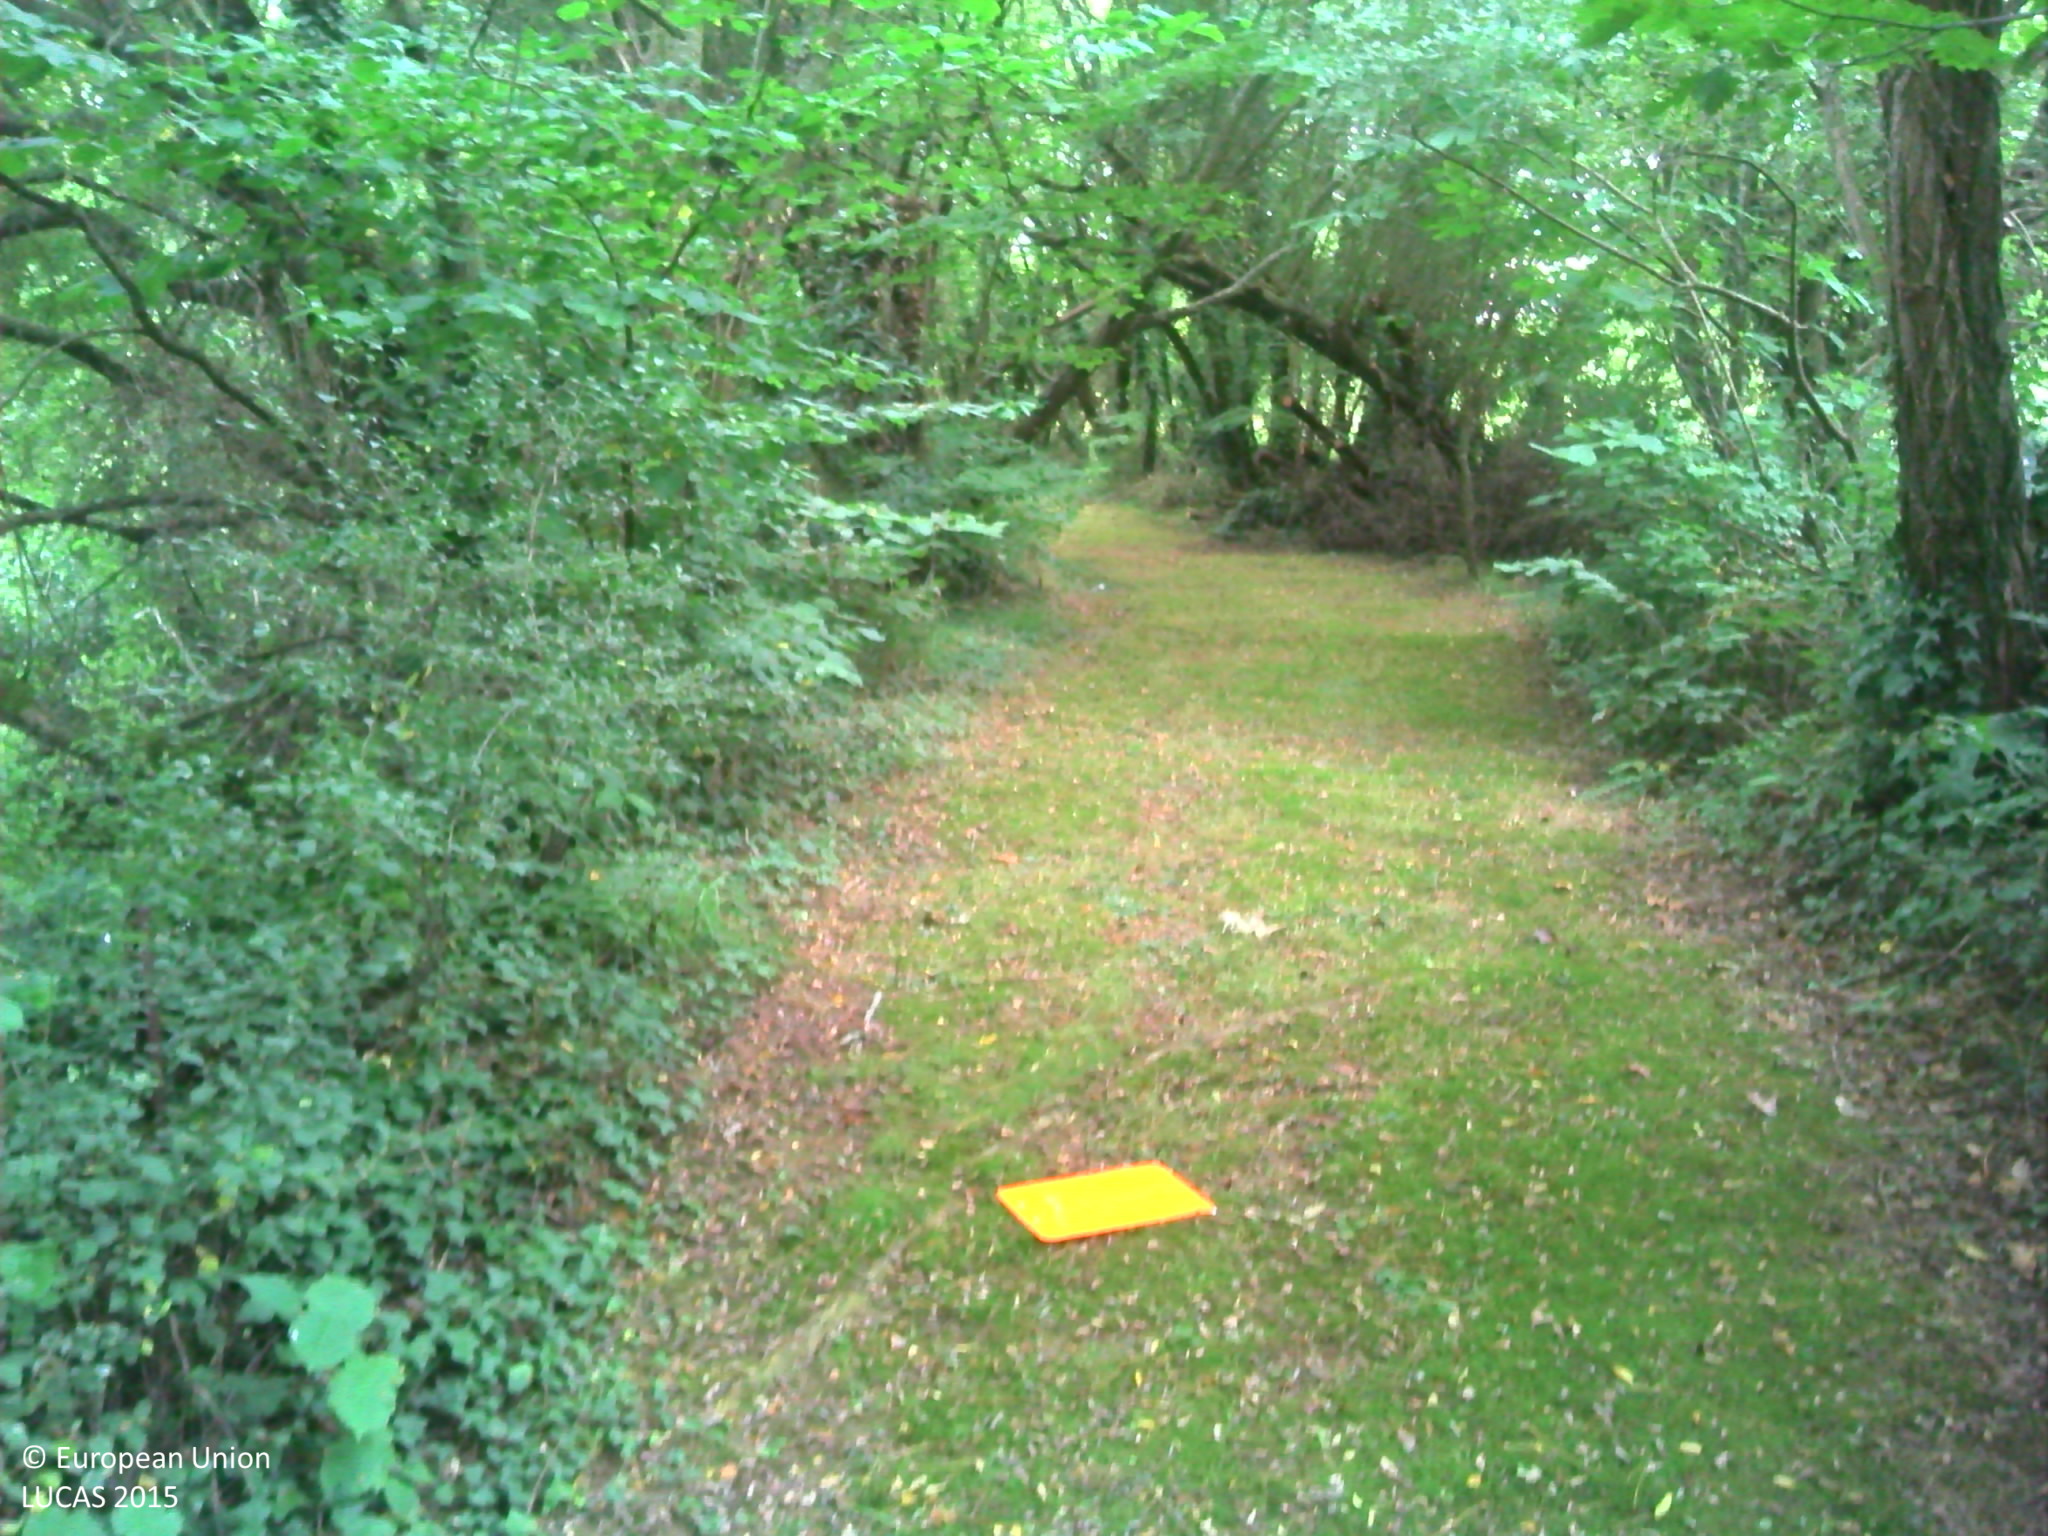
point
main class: Woodland
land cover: Broadleaved woodland
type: mesophytic deciduous forest
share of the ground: > 75 %
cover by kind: broadleaved forest trees 100 %
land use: Residential
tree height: > 5 m
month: August
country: FR
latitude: 46.6777
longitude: -1.6361
